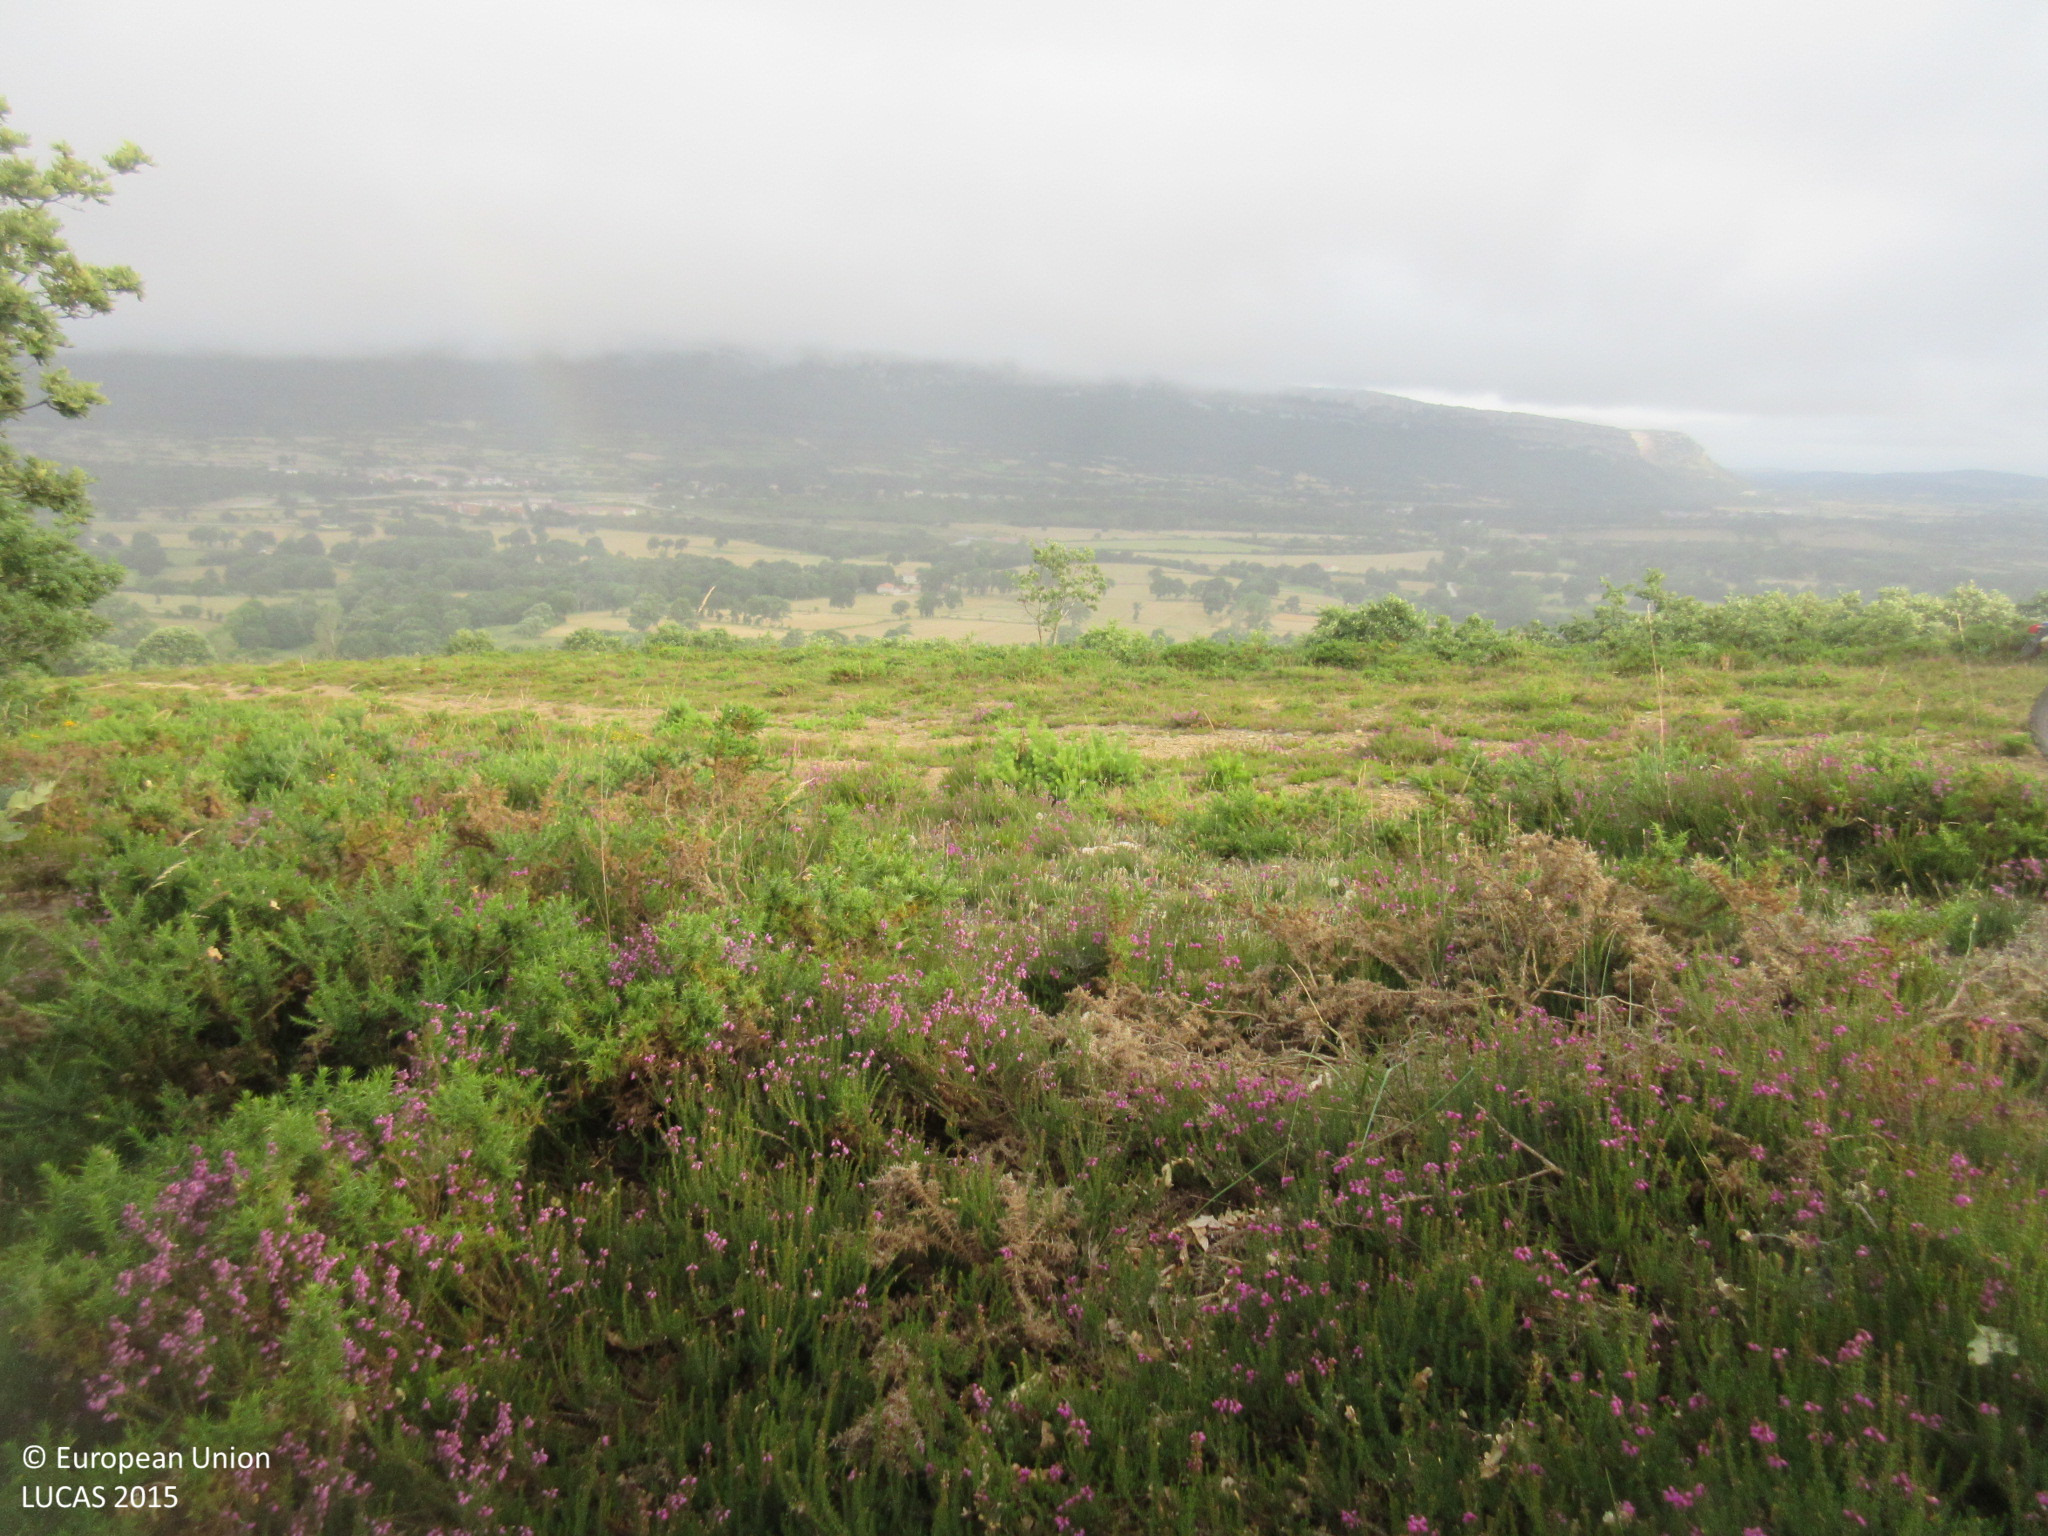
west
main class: Woodland
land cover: Broadleaved woodland
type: acidophilous oak and oak-birch forest
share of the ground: > 75 %
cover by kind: broadleaved forest trees 100 %
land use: Forestry
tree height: > 5 m
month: July
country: ES
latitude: 43.1023
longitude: -3.4703
